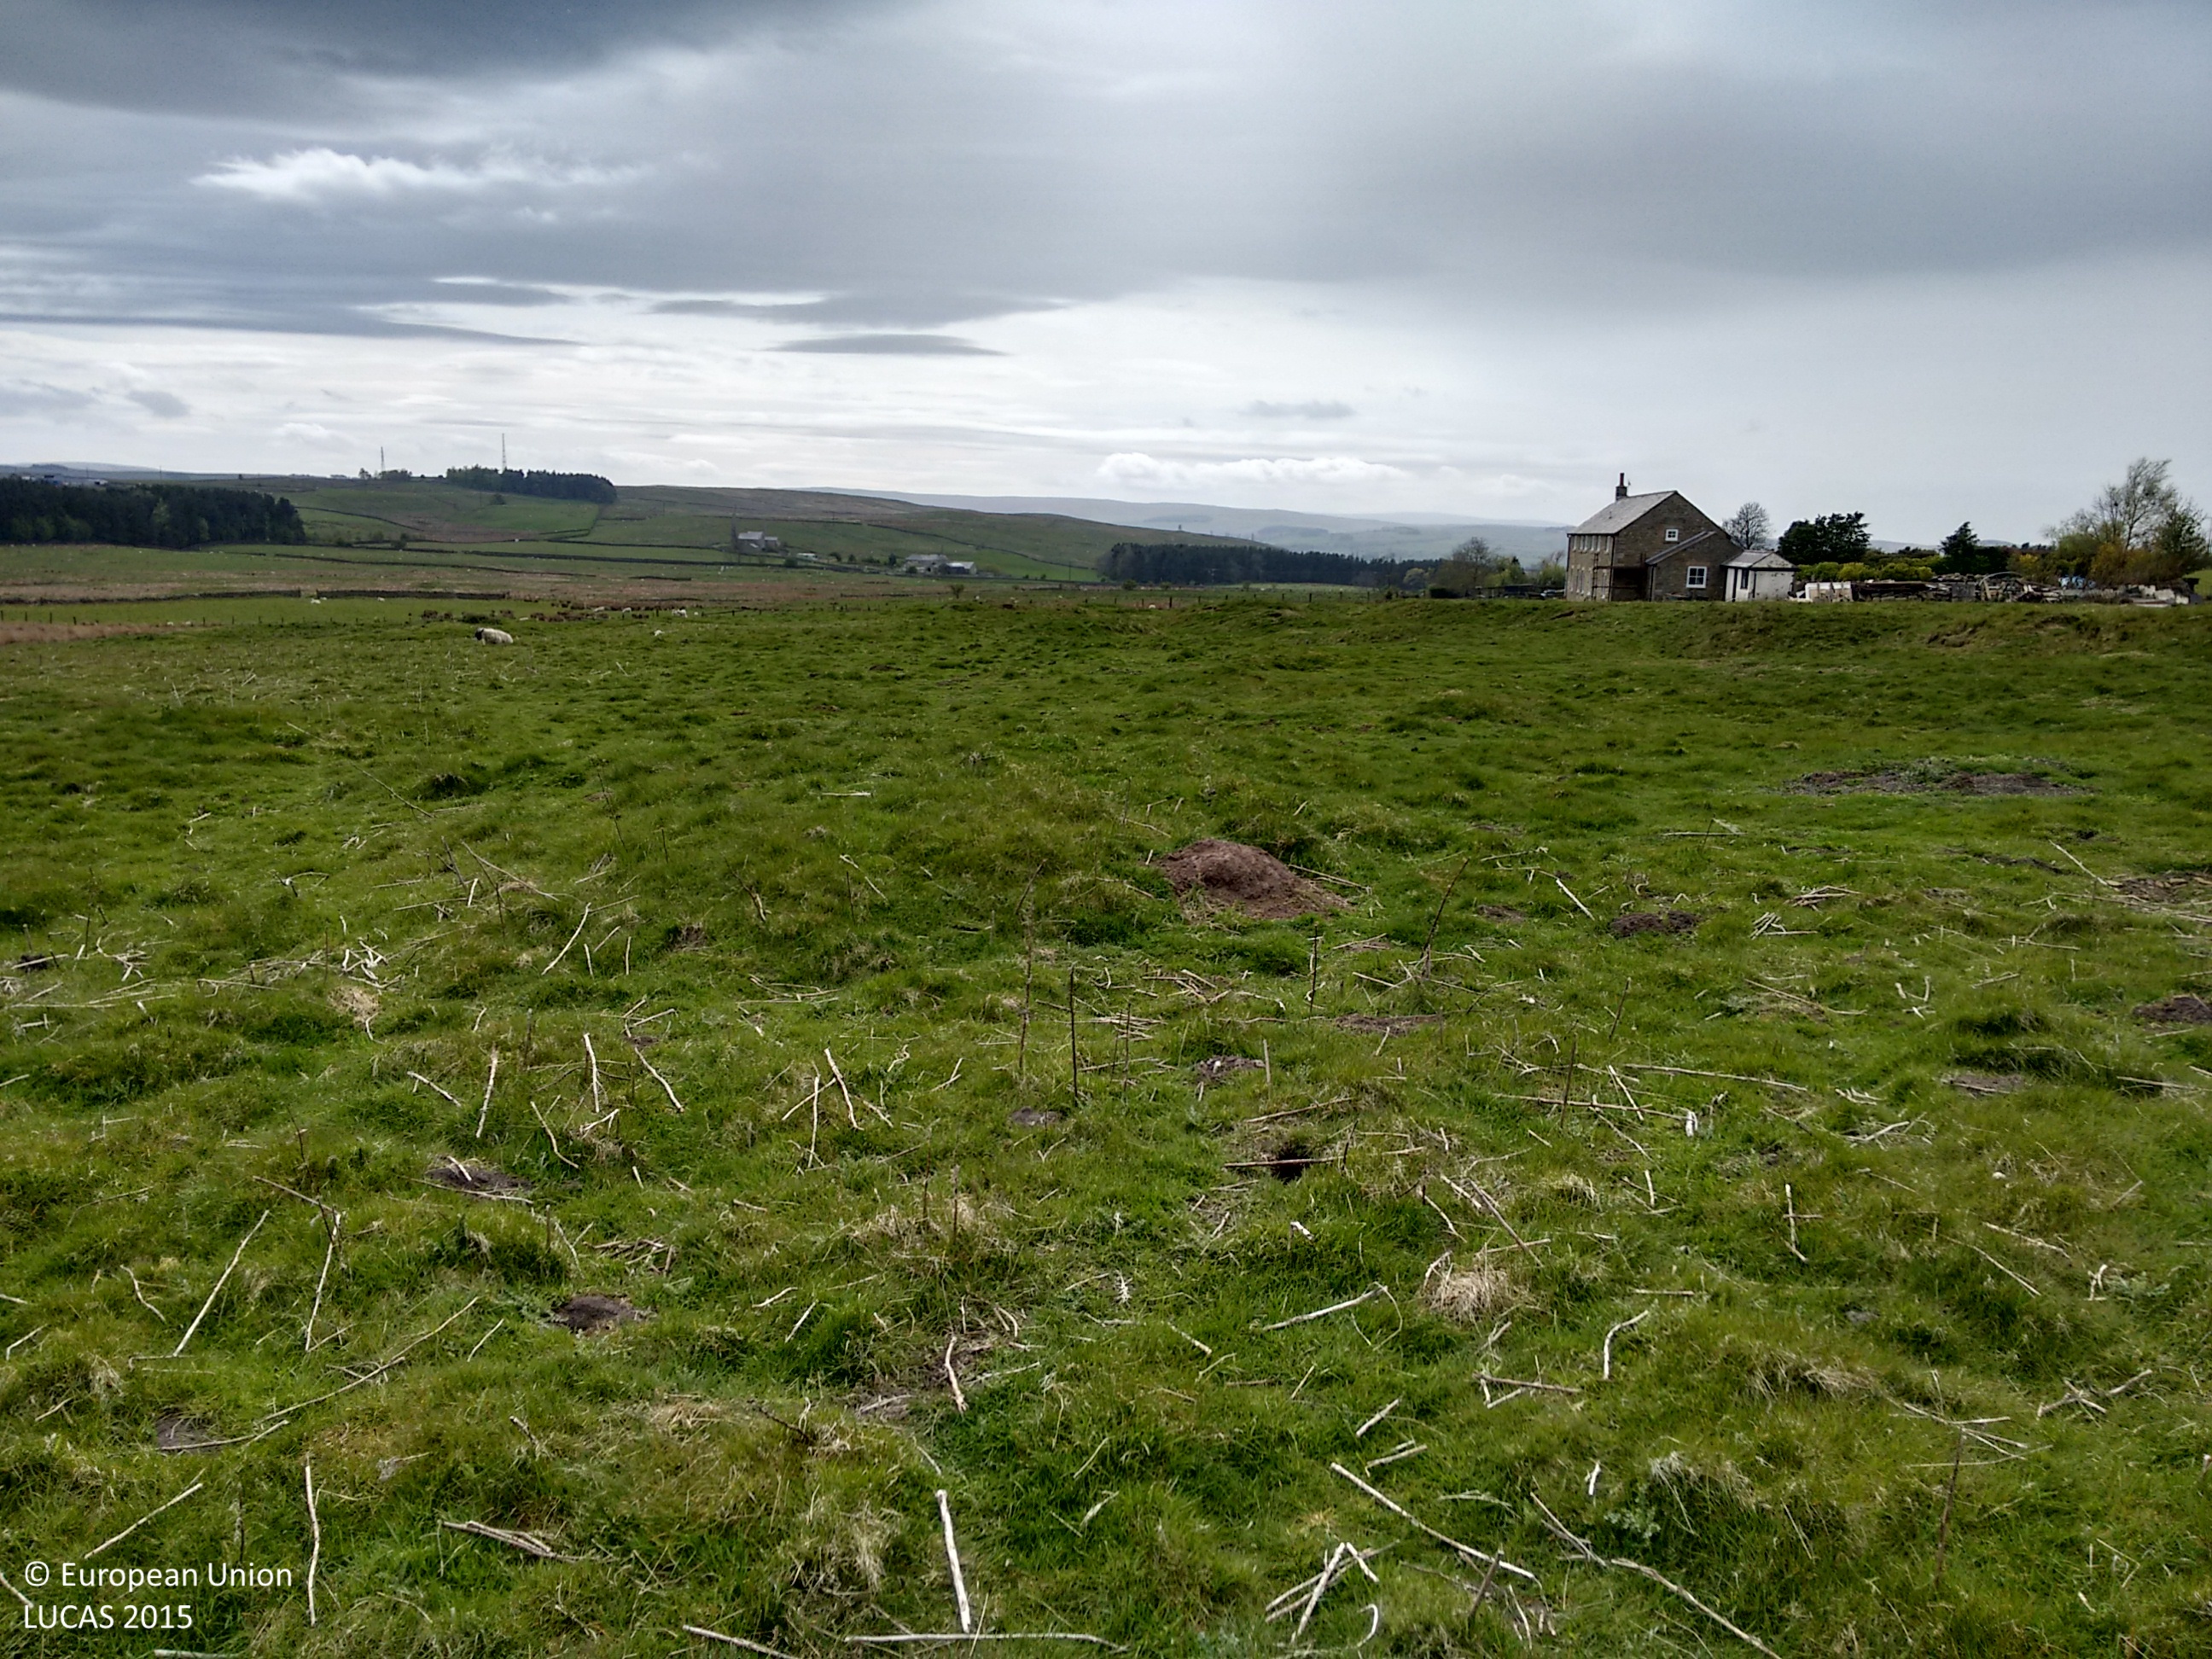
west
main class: Grassland
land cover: Grassland without tree/shrub cover
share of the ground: > 75 %
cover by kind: herbaceous plants 100 %
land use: Agriculture (excluding fallow land and kitchen gardens)
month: May
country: GB
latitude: 54.9427
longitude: -2.2506
